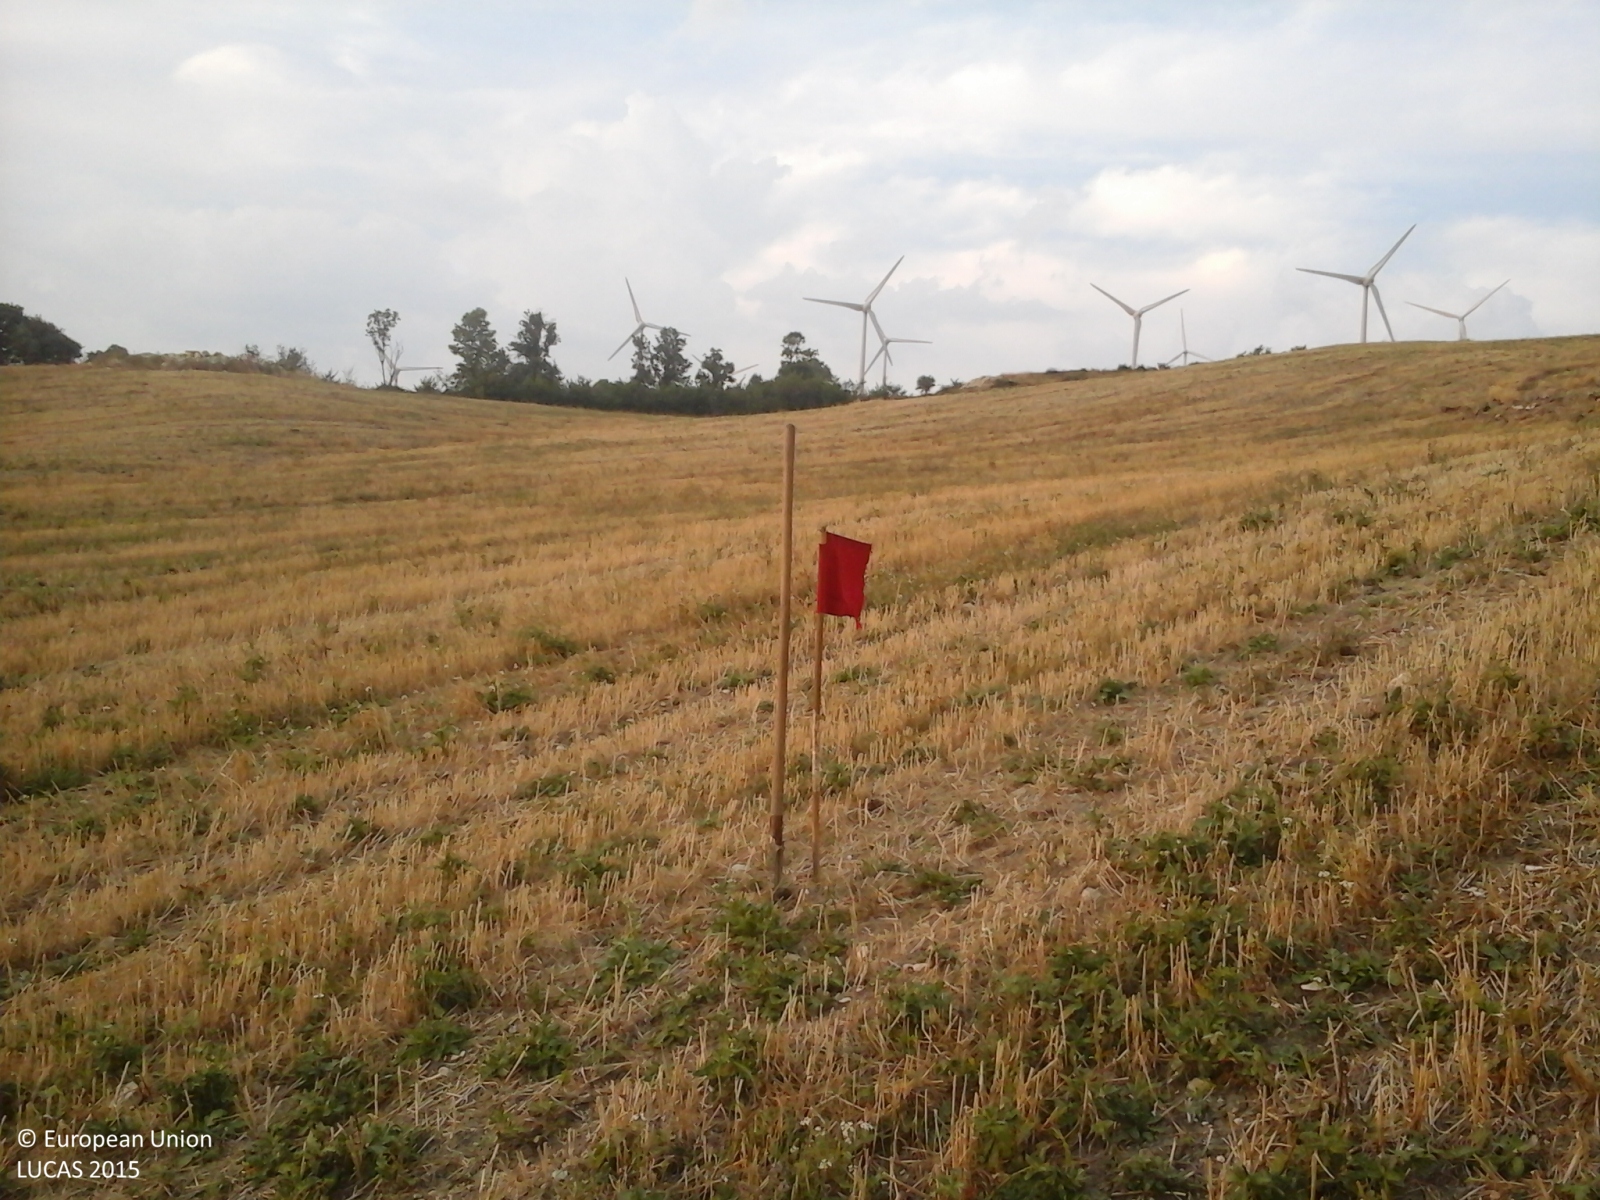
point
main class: Cropland
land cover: Durum wheat
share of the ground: > 75 %
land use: Agriculture (excluding fallow land and kitchen gardens)
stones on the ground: 10 - 25 %
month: August
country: IT
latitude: 41.3111
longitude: 15.1301
